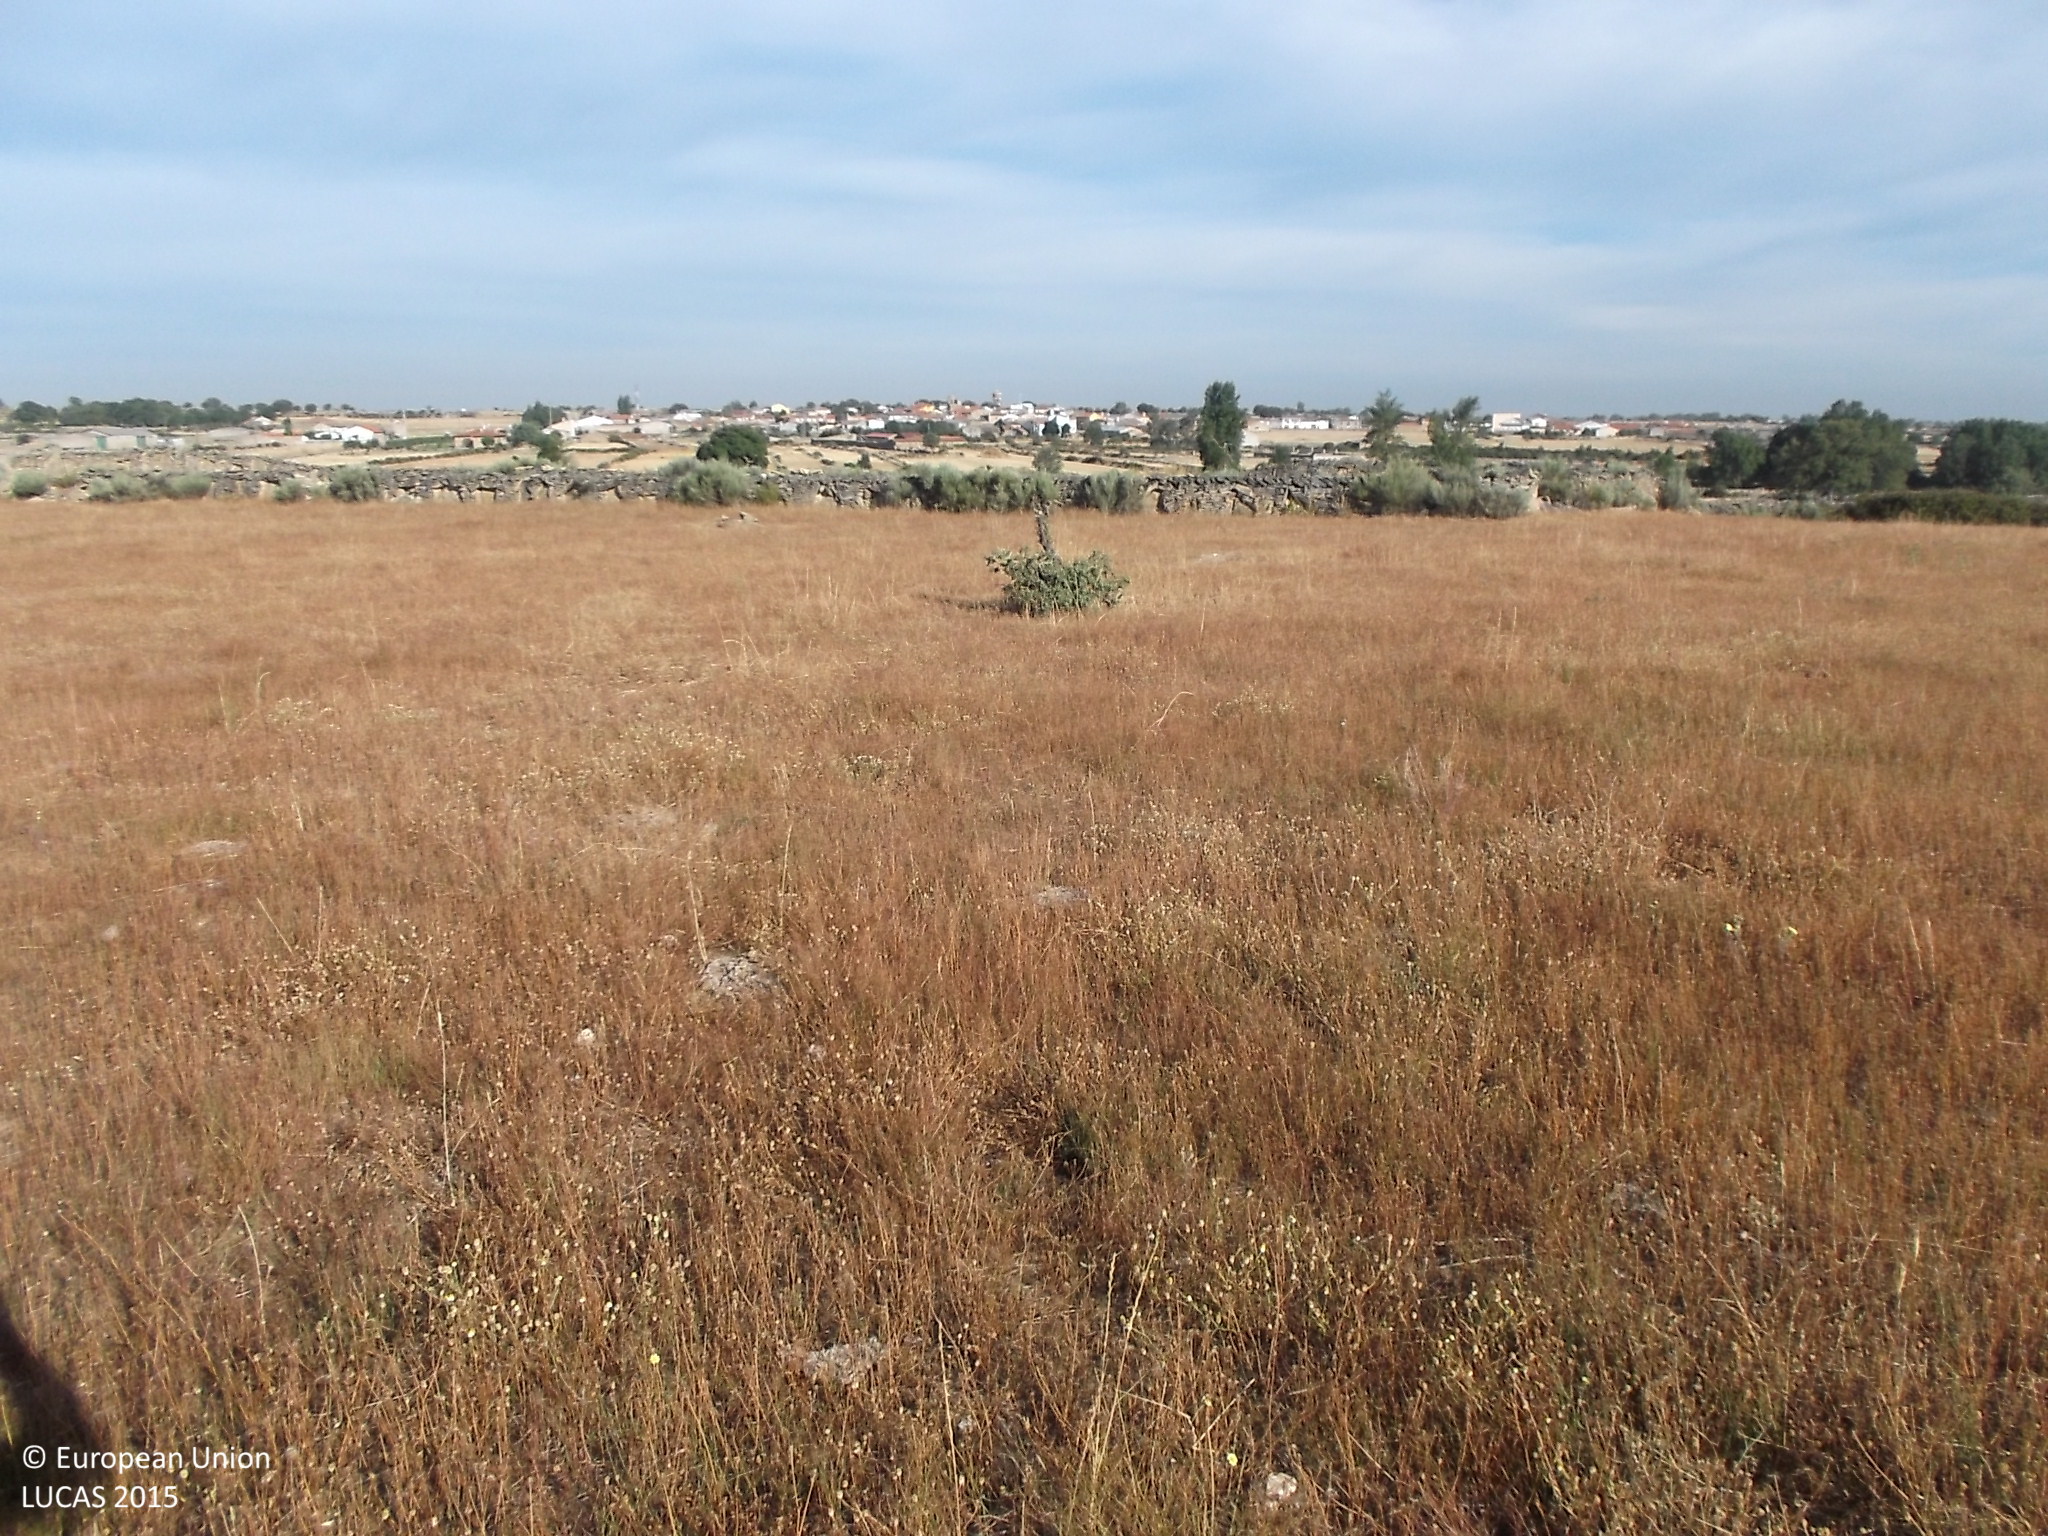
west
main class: Grassland
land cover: Grassland without tree/shrub cover
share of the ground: > 75 %
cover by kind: herbaceous plants 100 %
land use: Agriculture (excluding fallow land and kitchen gardens)
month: July
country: ES
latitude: 41.2261
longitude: -6.3308
